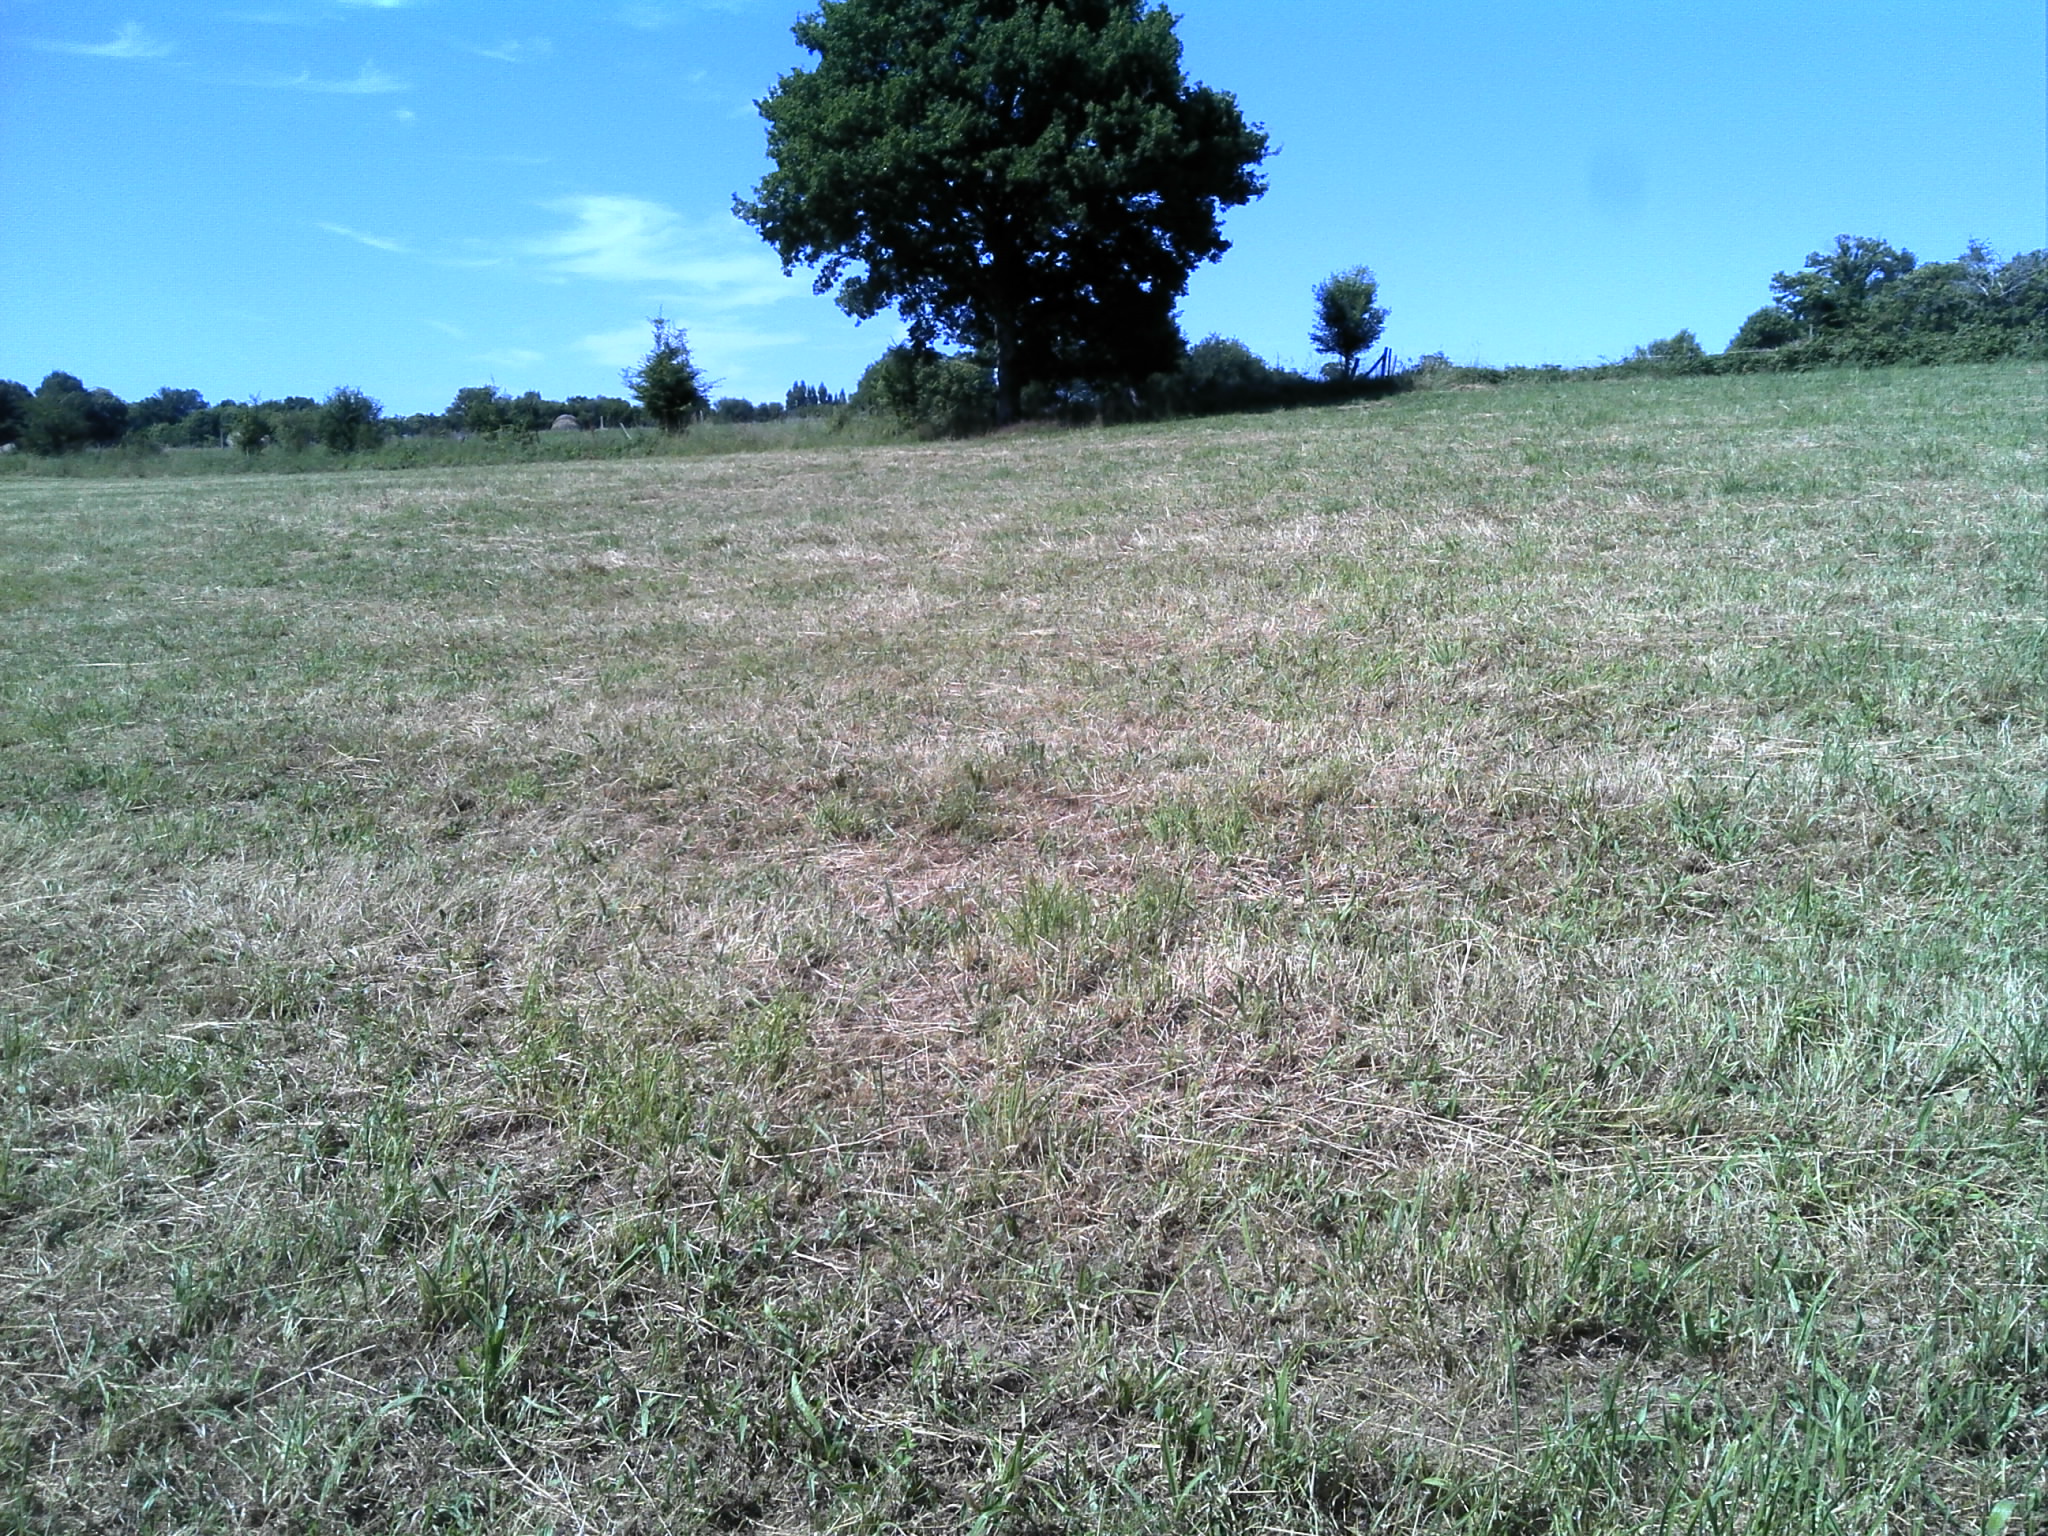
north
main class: Grassland
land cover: Grassland without tree/shrub cover
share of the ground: > 75 %
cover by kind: herbaceous plants 100 %
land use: Agriculture (excluding fallow land and kitchen gardens)
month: June
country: FR
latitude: 46.4303
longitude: 1.5182
